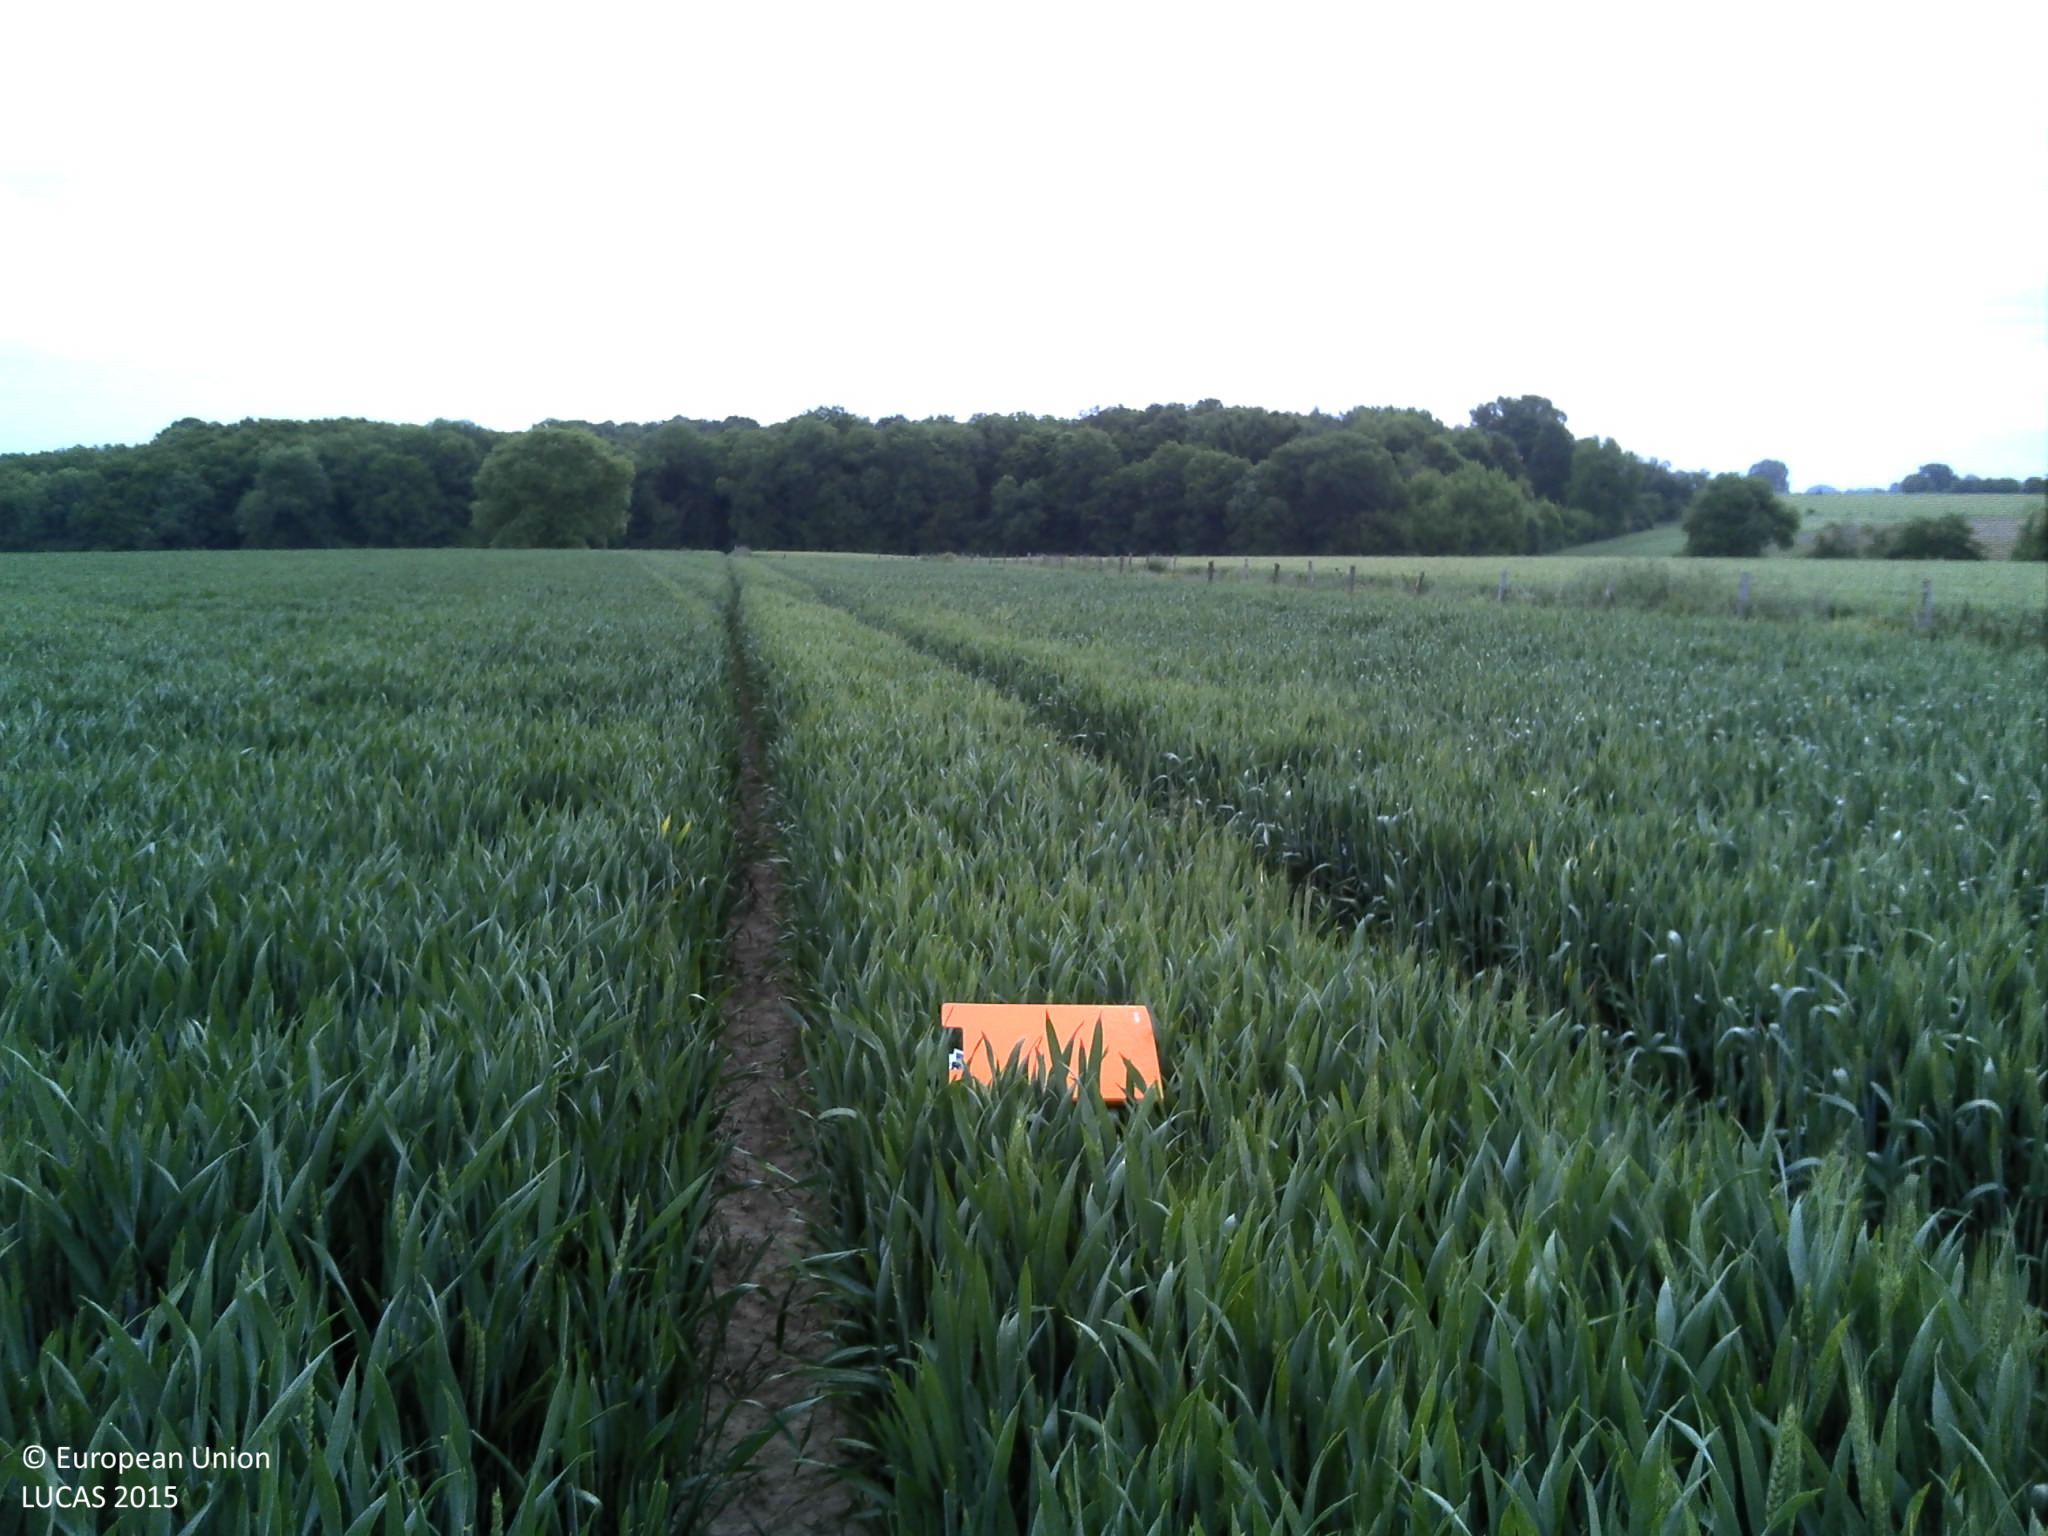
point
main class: Cropland
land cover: Durum wheat
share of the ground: > 75 %
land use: Agriculture (excluding fallow land and kitchen gardens)
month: May
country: FR
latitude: 49.3936
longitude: 1.2306
